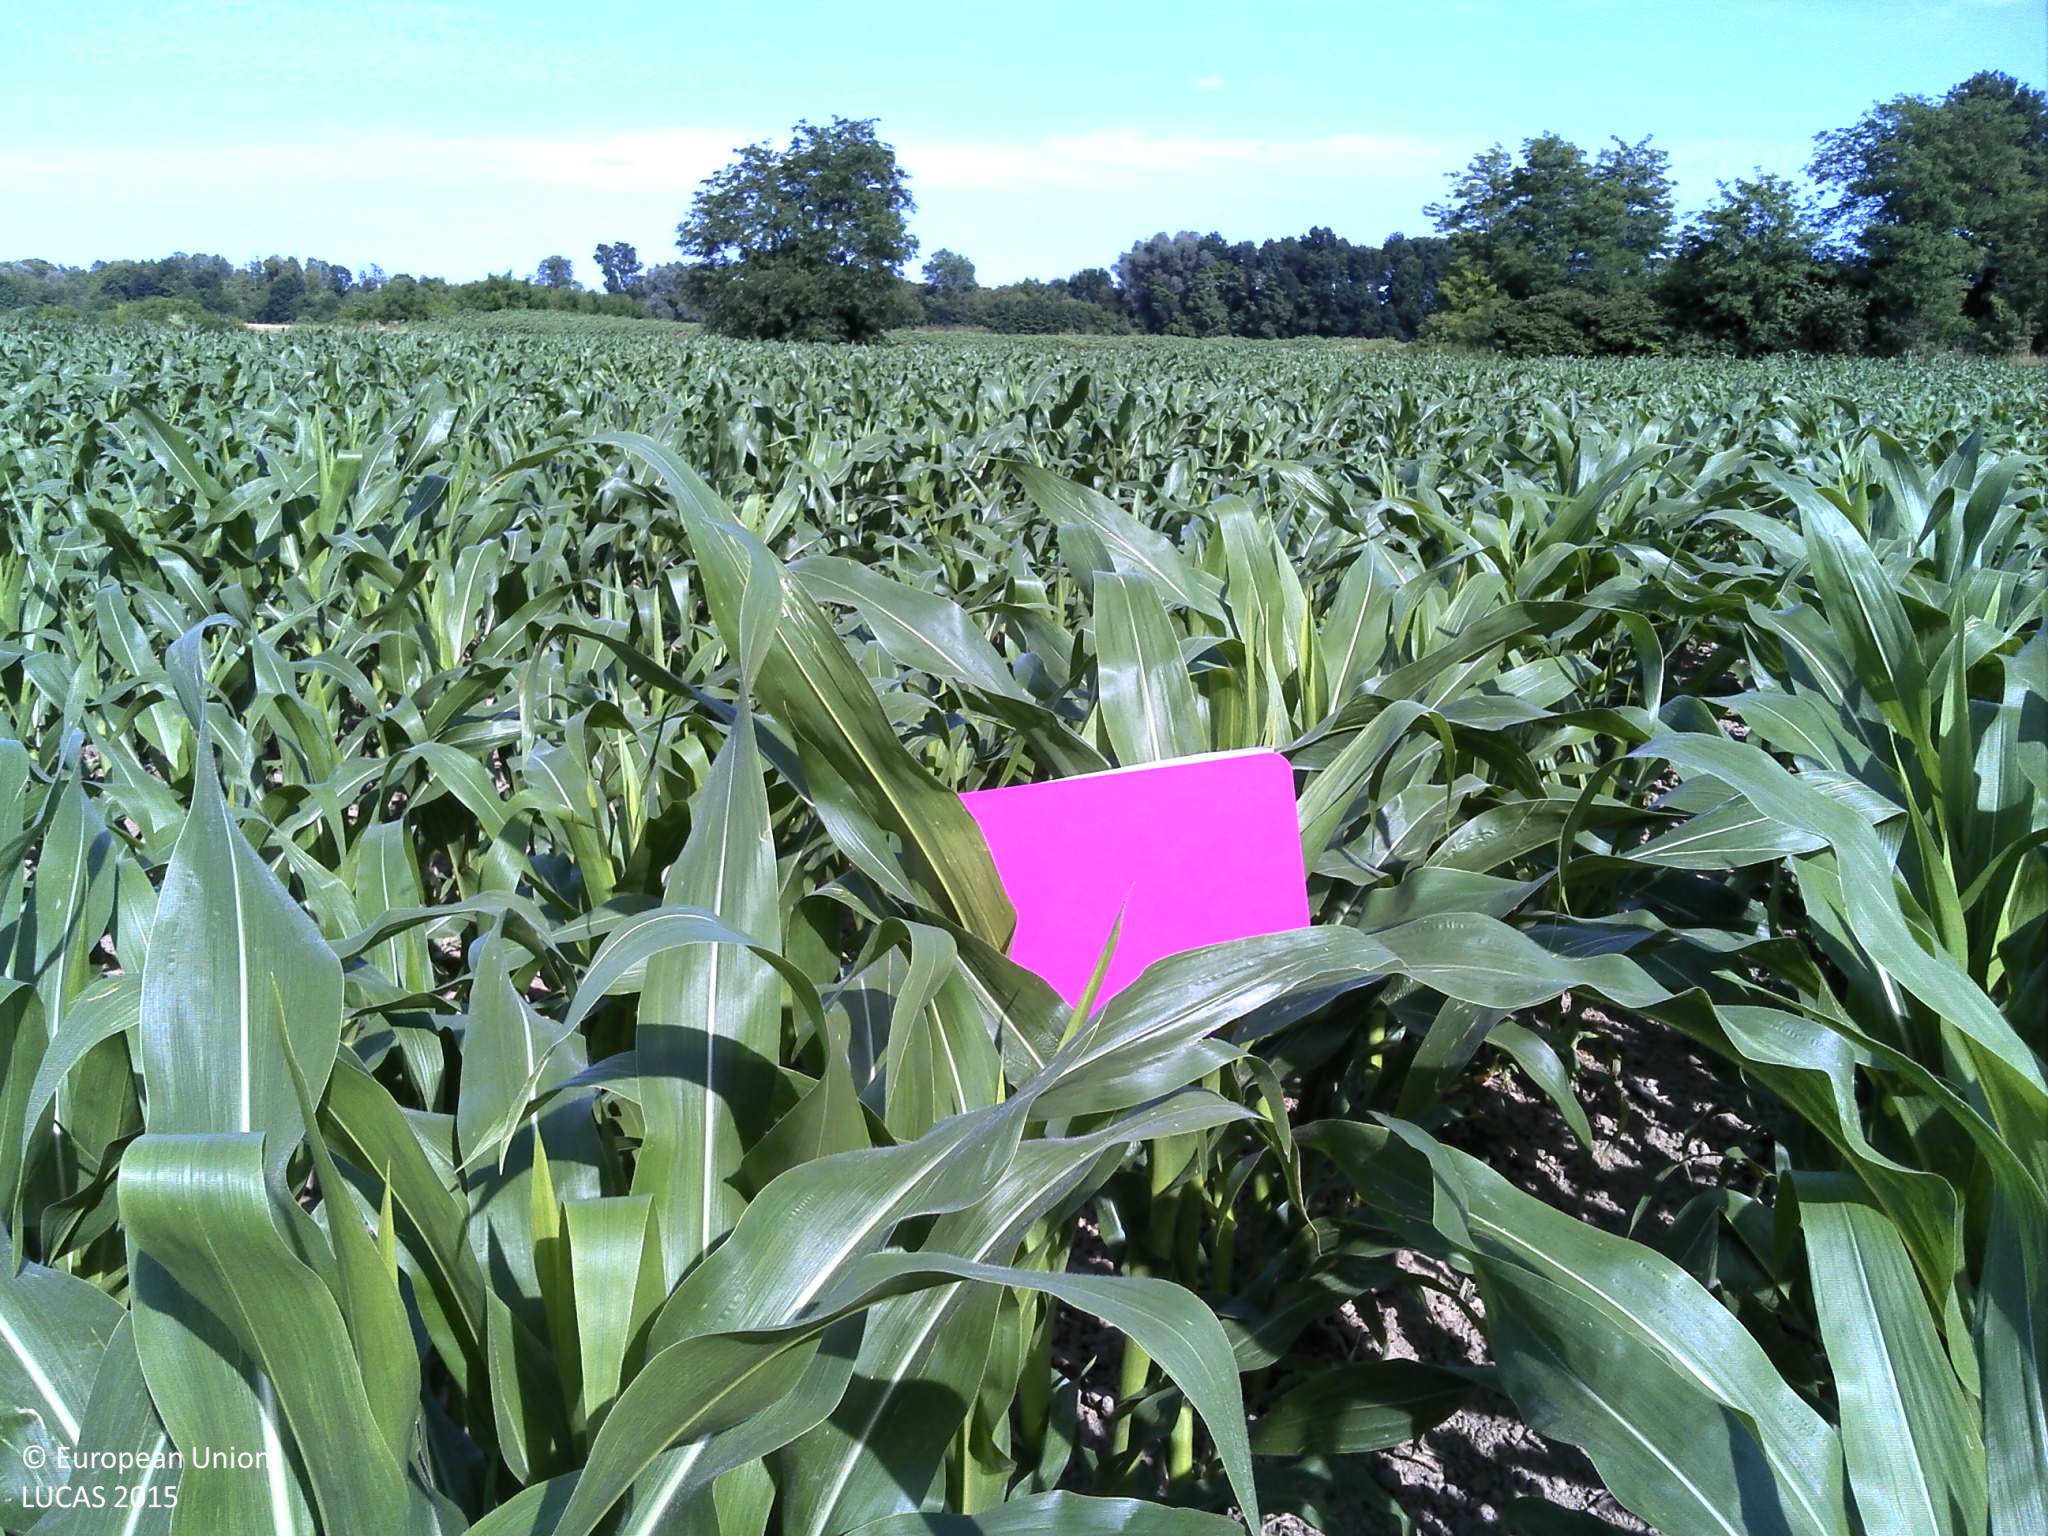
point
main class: Cropland
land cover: Maize
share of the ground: > 75 %
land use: Agriculture (excluding fallow land and kitchen gardens)
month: June
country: HR
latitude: 45.9037
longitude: 17.5438
